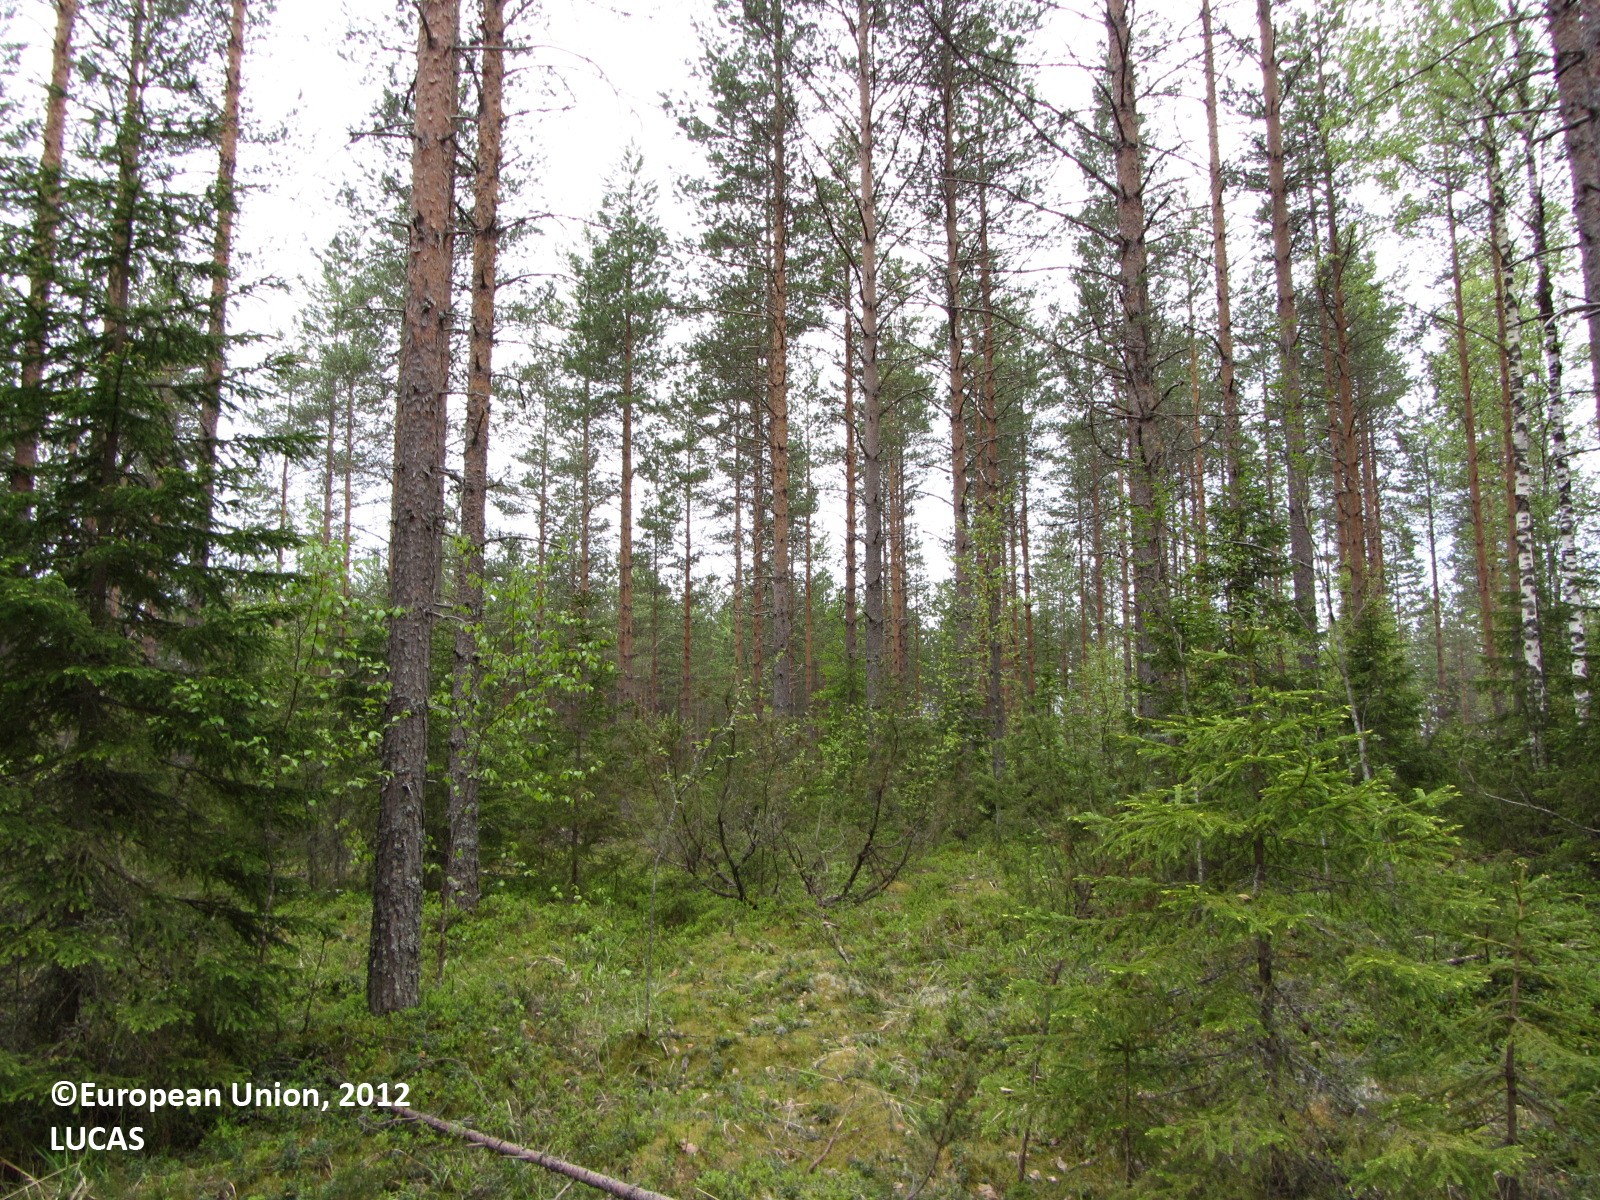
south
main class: Woodland
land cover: Pine dominated mixed woodland
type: boreal forest
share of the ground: > 75 %
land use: Forestry
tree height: > 5 m
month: May
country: FI
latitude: 62.3314
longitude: 25.3798
